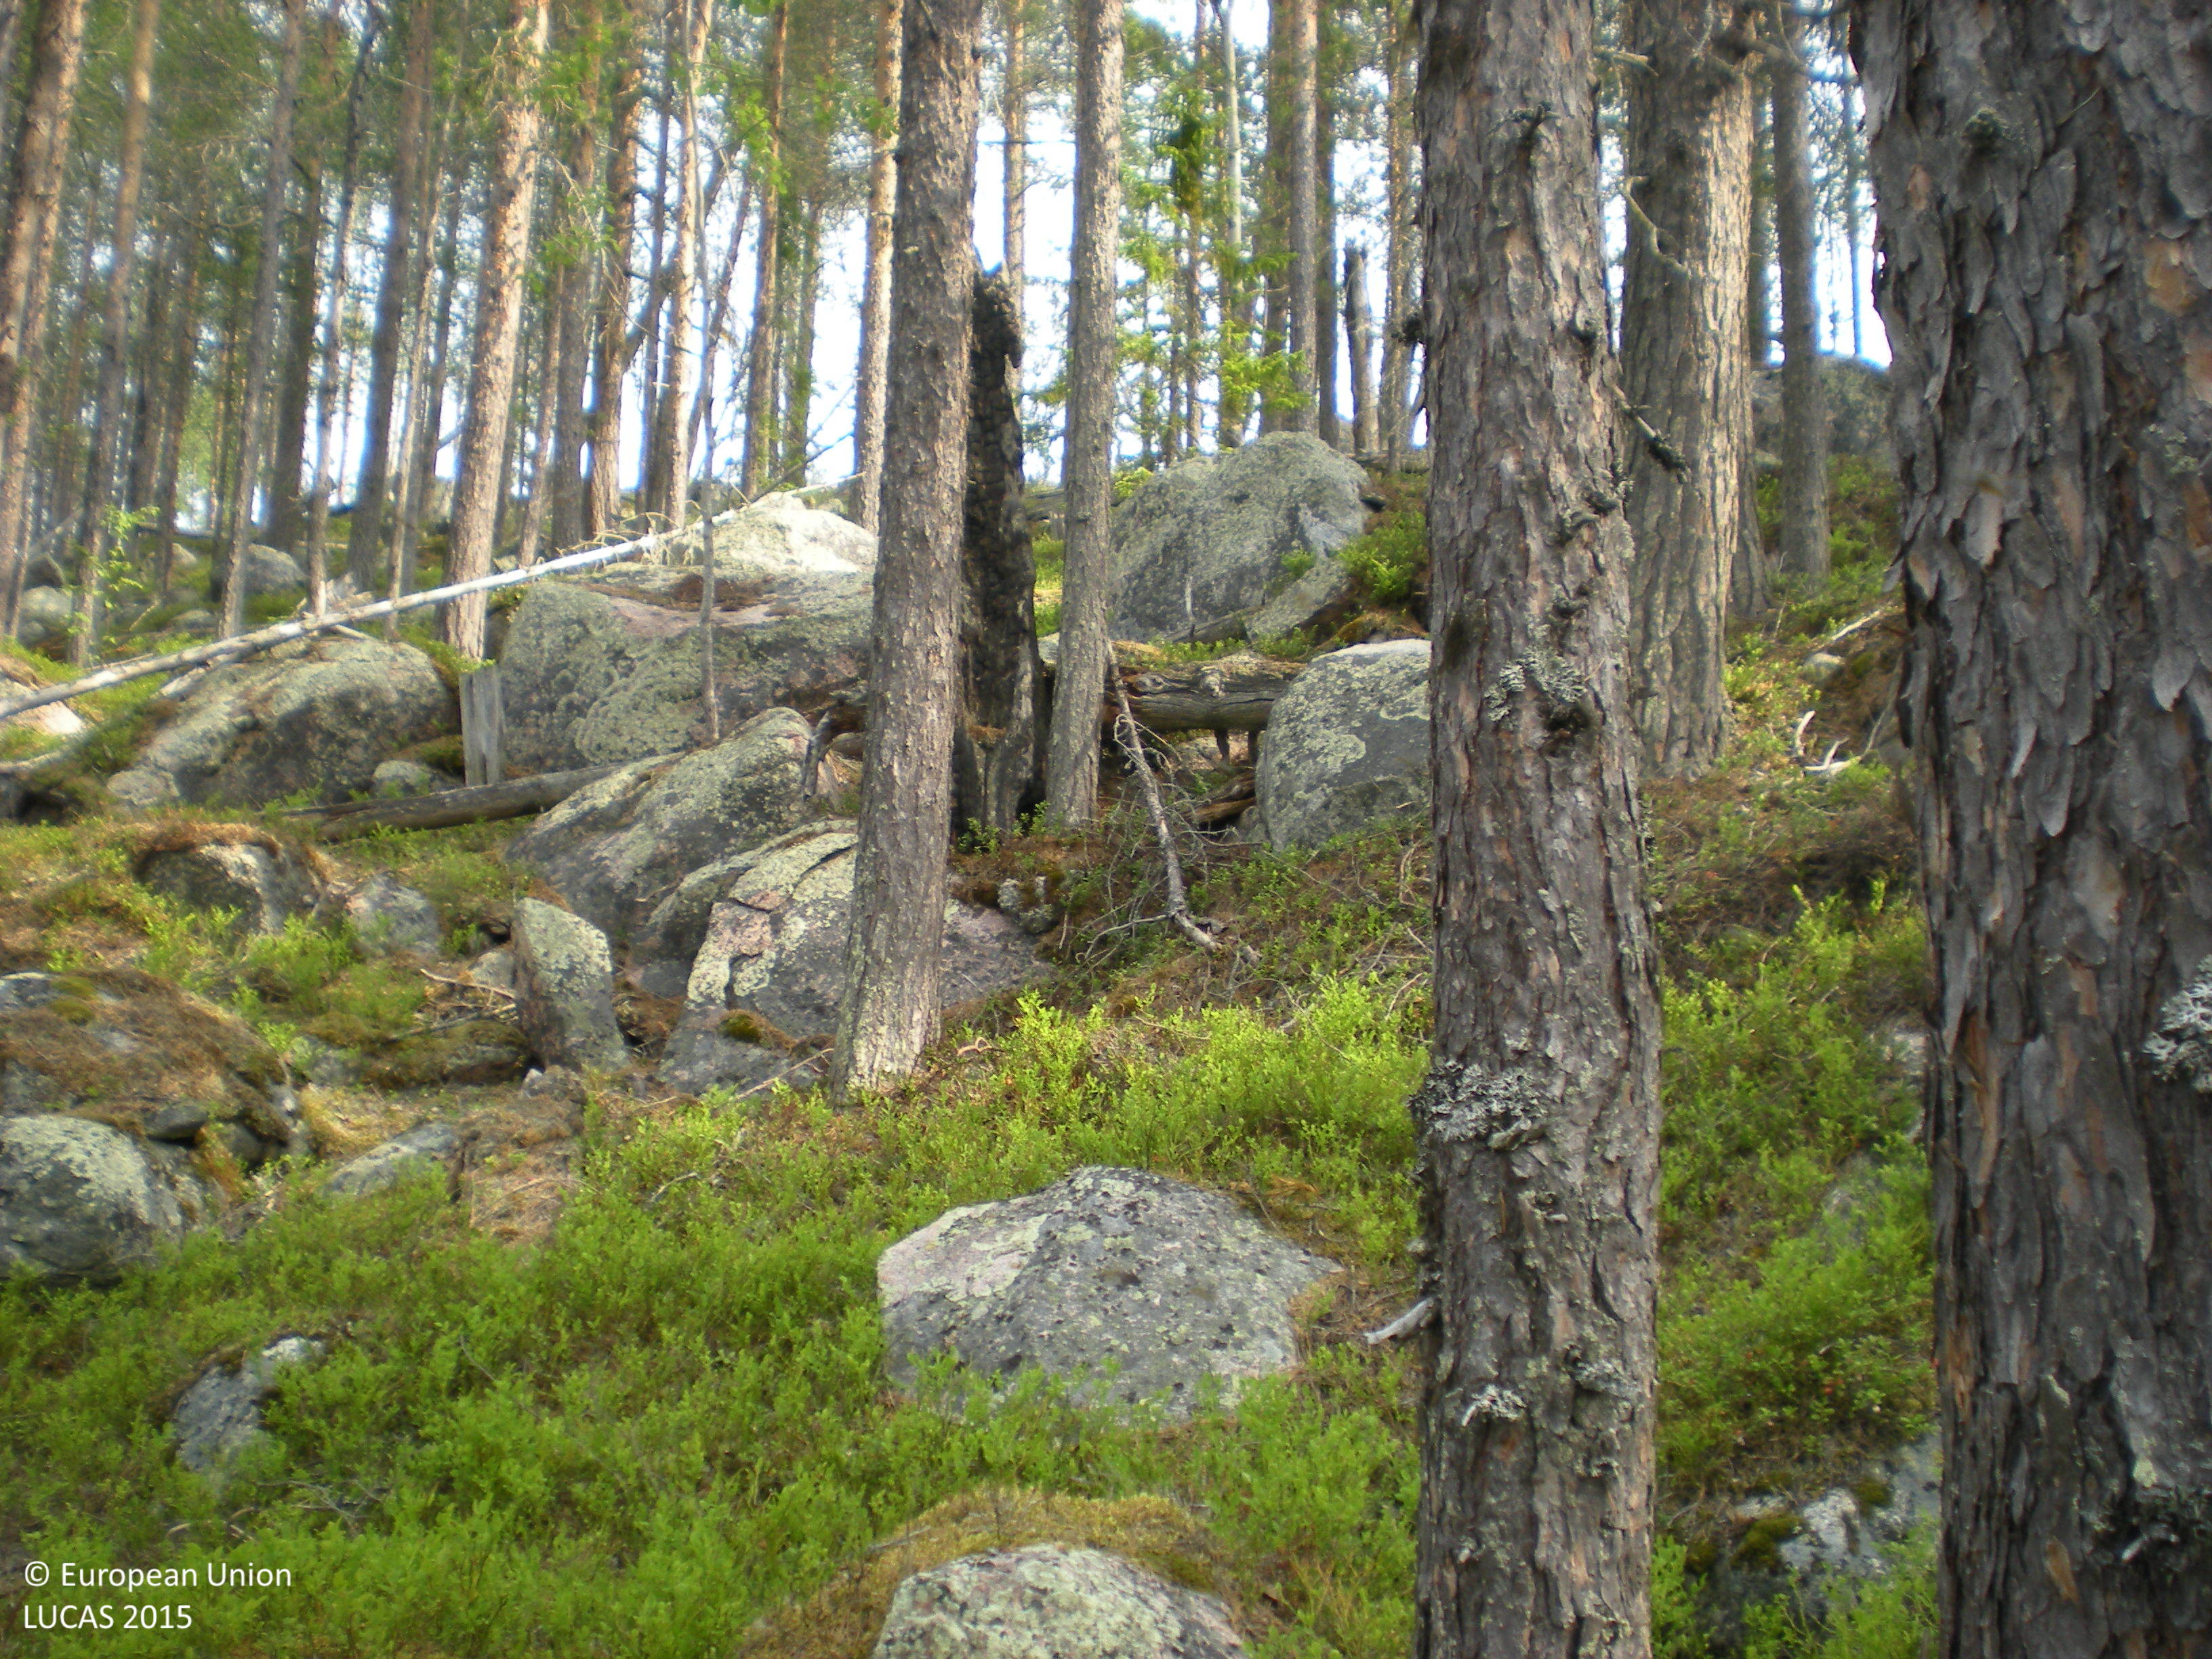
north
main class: Woodland
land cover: Pine dominated coniferous woodland
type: boreal forest
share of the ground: 50 - 75 %
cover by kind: coniferous forest trees 55 %, consolidated bare surface 30 %, shrubs 10 %, lichens and mosses 5 %
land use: Forestry
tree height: > 5 m
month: July
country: SE
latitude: 65.2708
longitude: 17.5669
